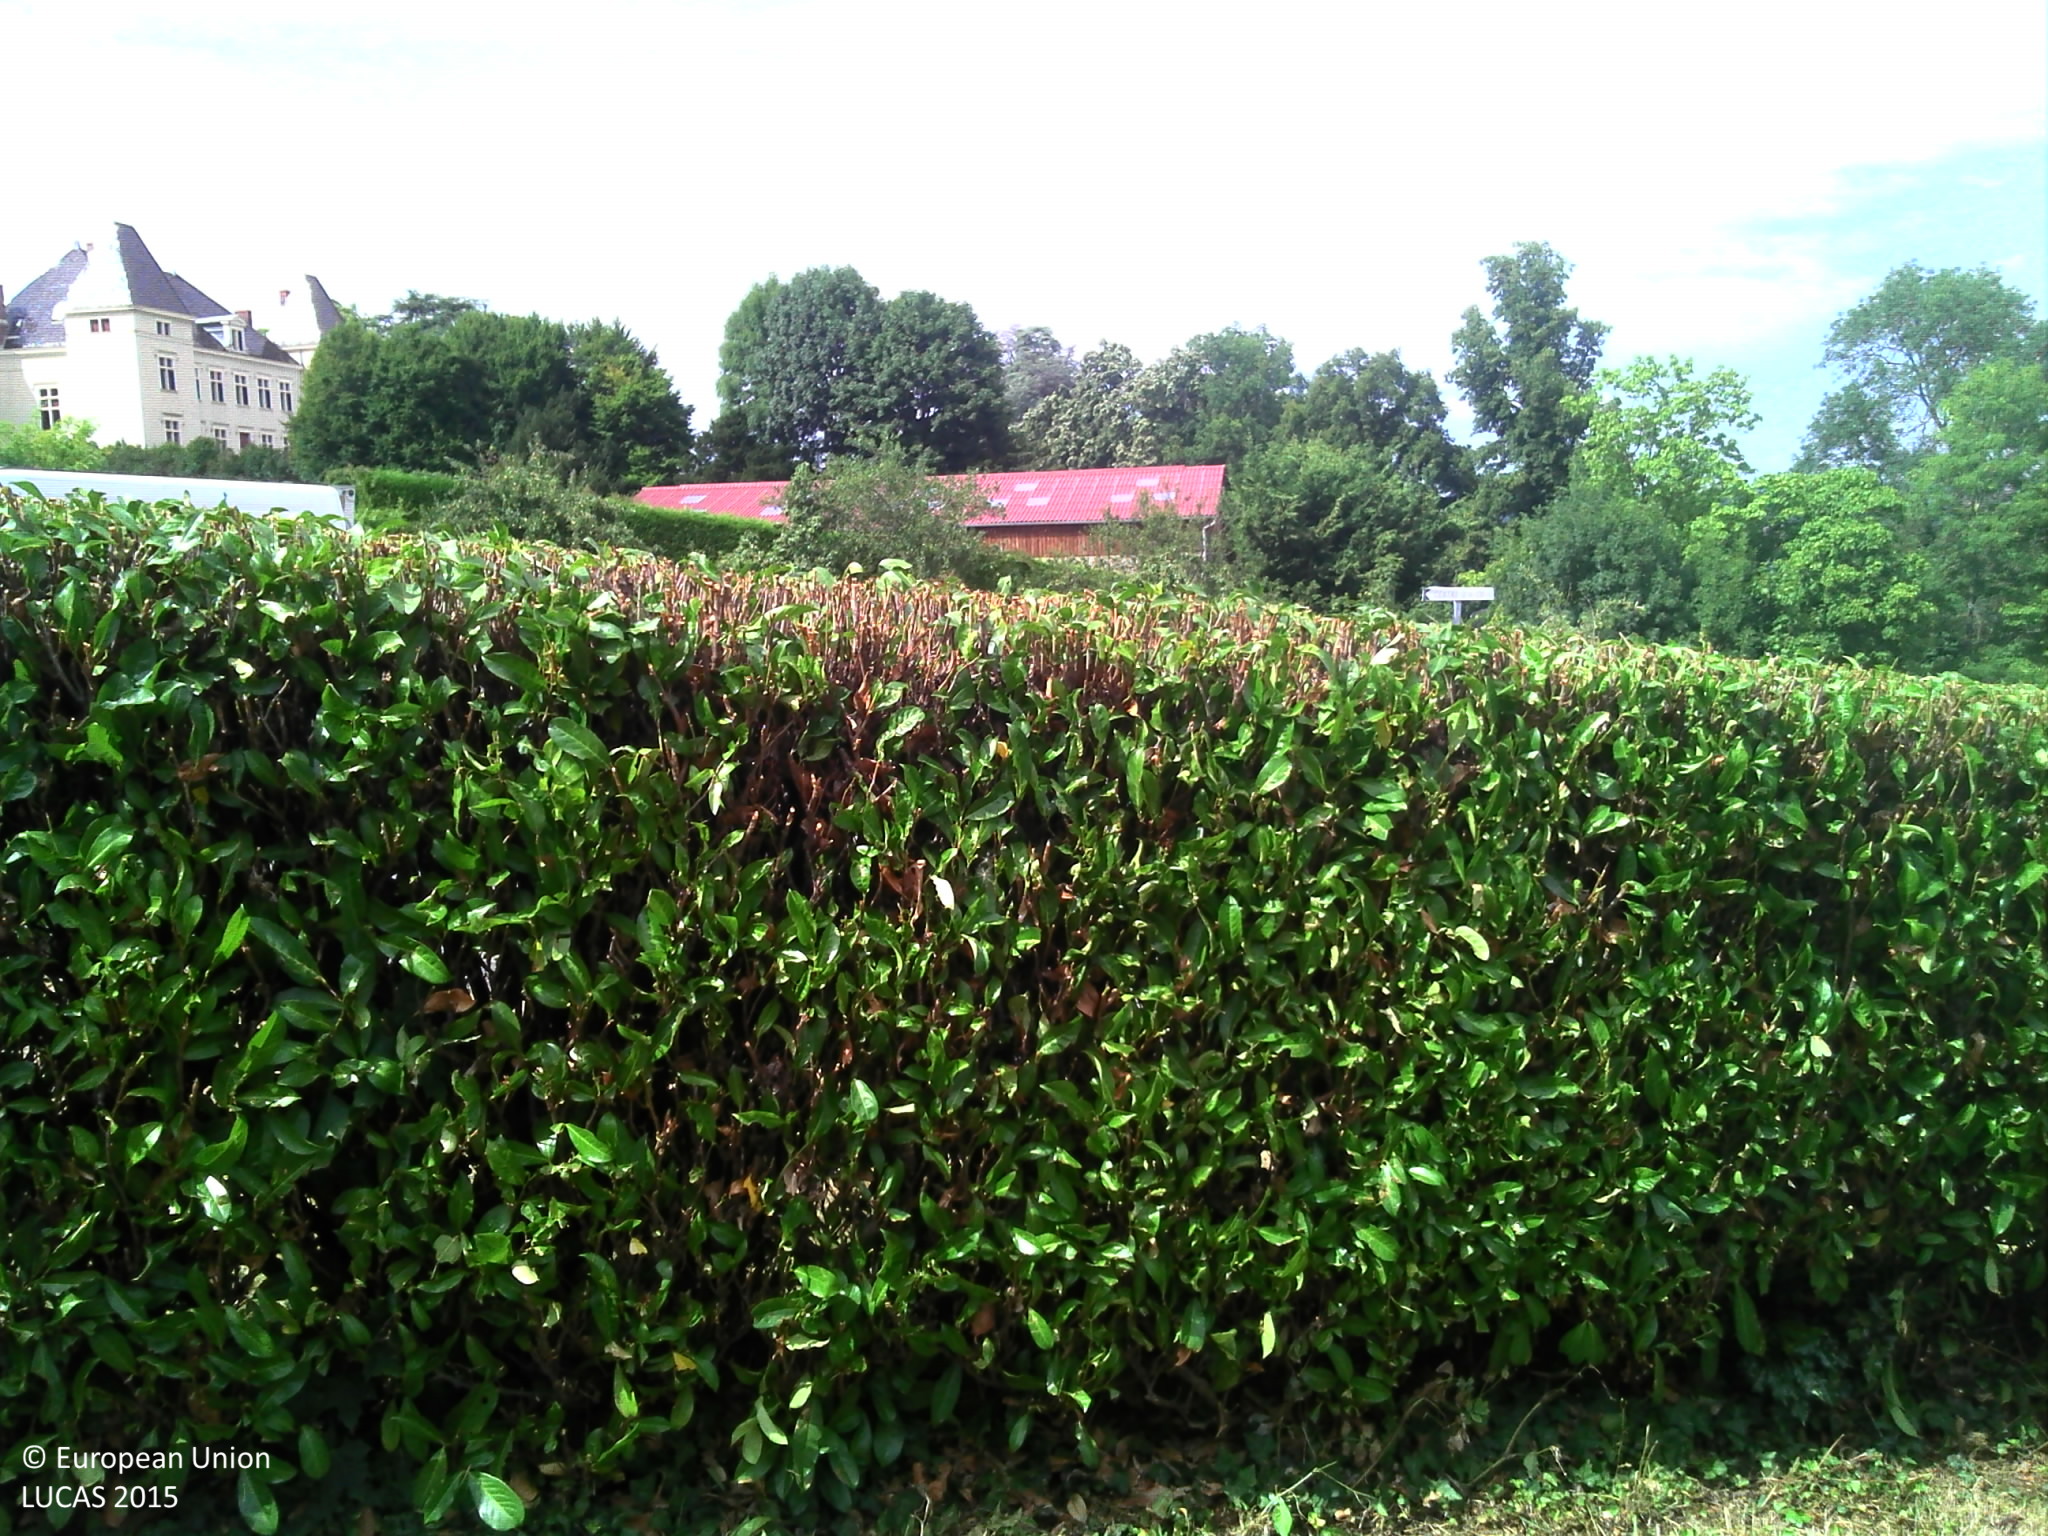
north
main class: Grassland
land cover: Grassland without tree/shrub cover
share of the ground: > 75 %
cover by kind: herbaceous plants 100 %
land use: Residential
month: July
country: FR
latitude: 45.6140
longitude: 4.5022
